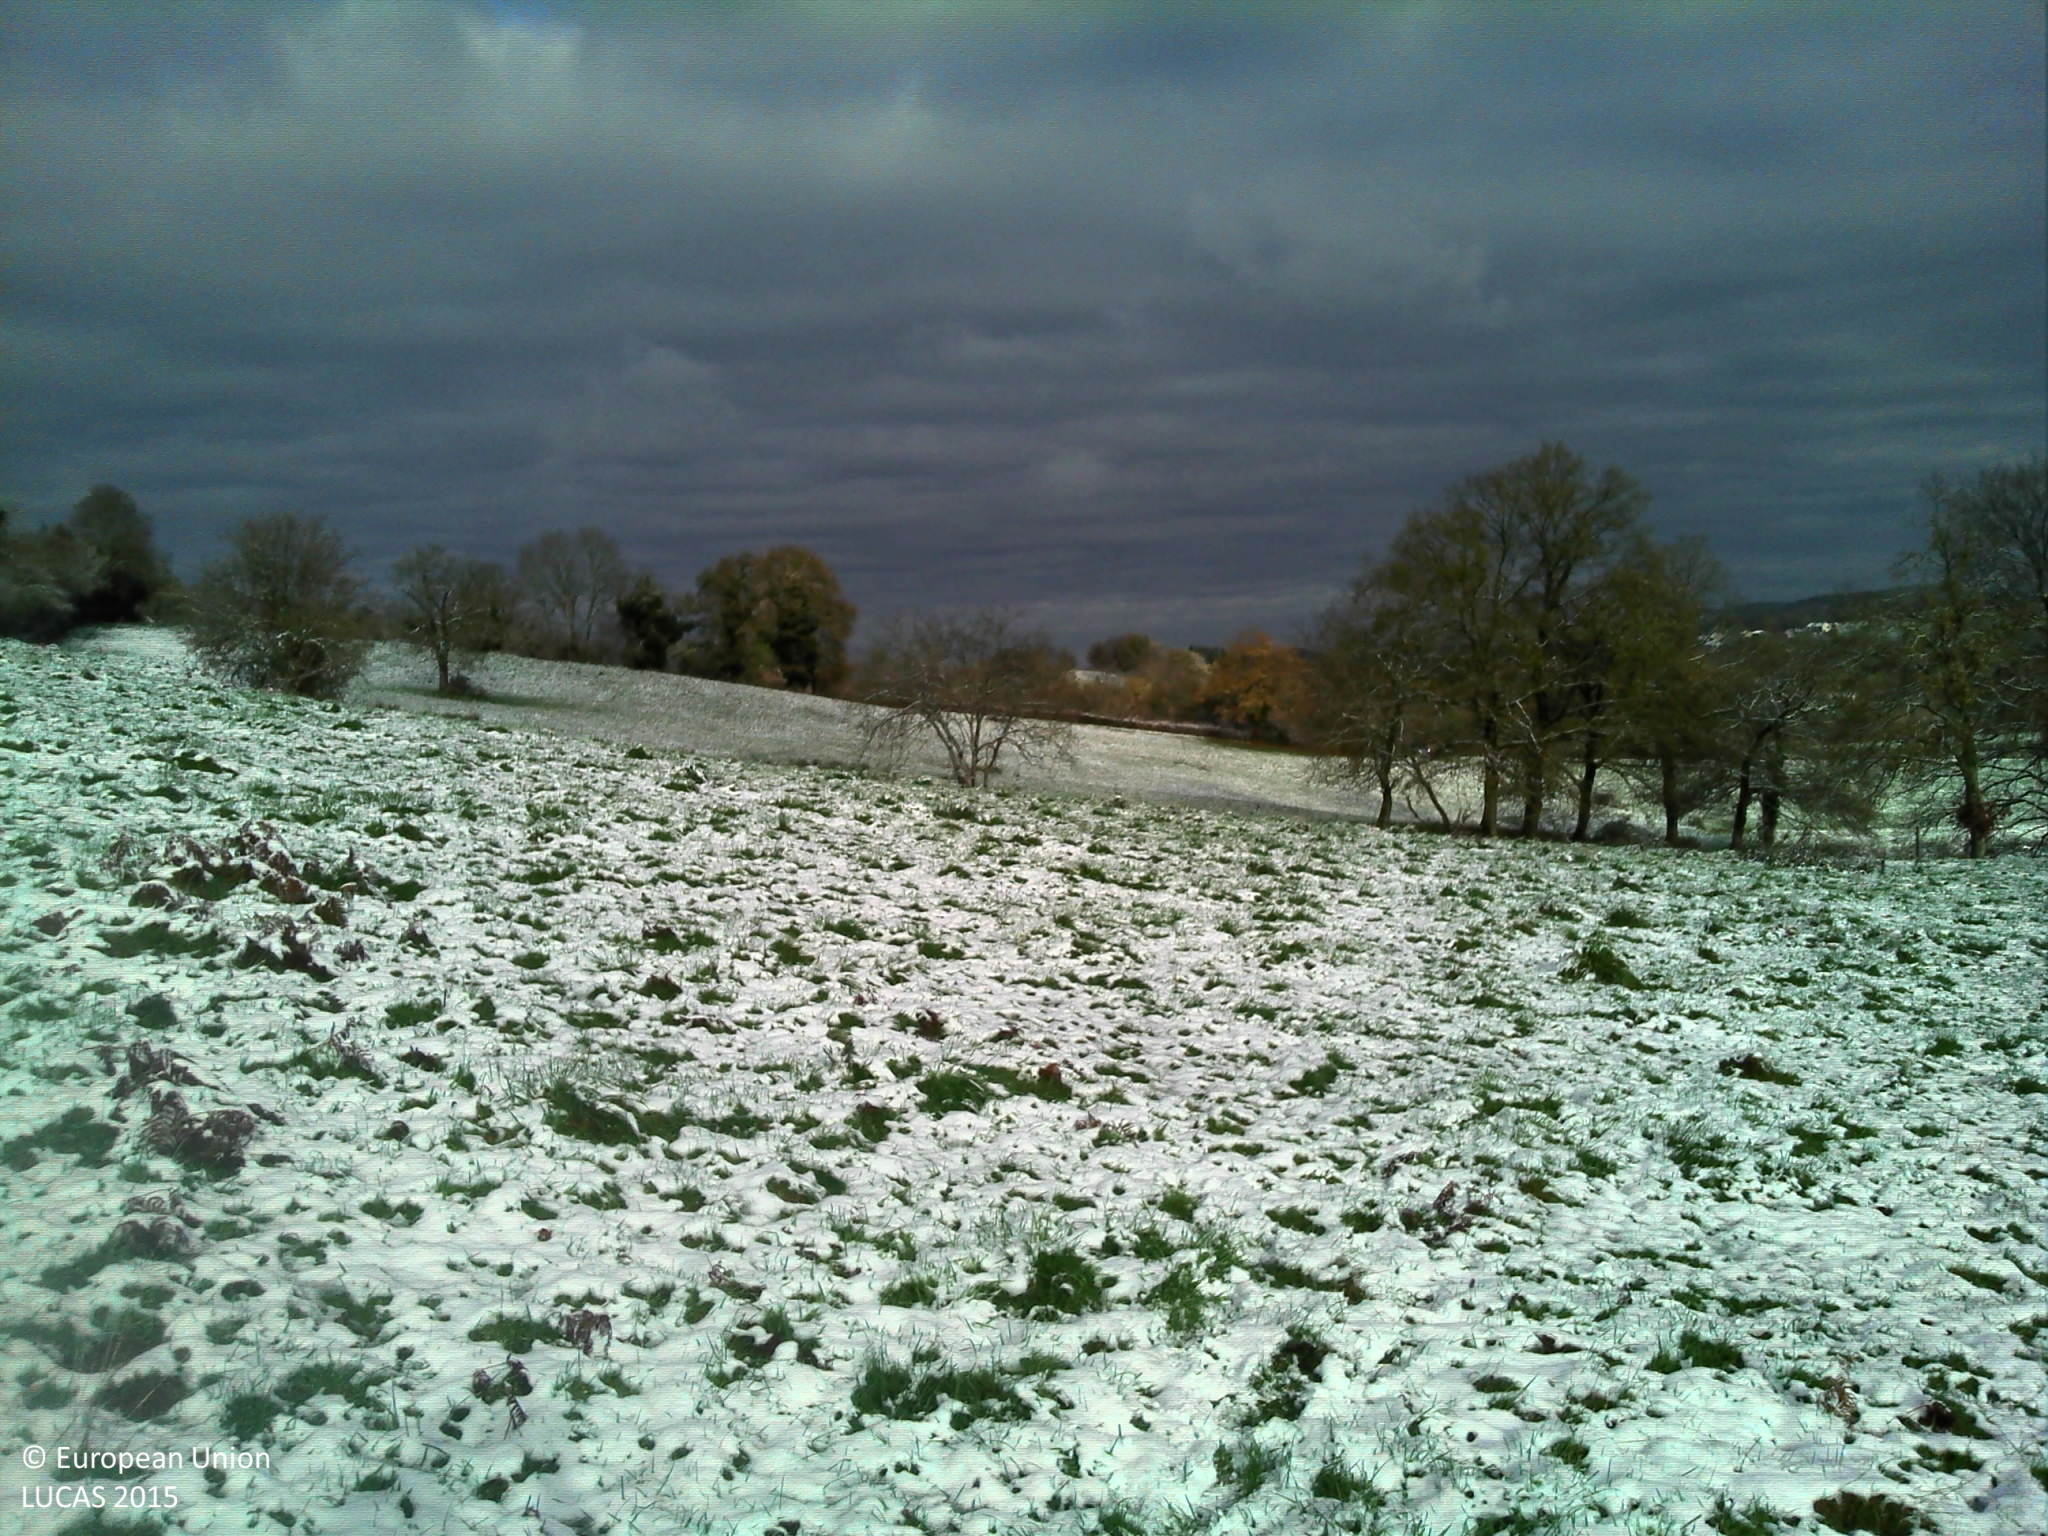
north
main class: Grassland
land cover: Grassland without tree/shrub cover
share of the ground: > 75 %
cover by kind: herbaceous plants 100 %
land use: Agriculture (excluding fallow land and kitchen gardens)
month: November
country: FR
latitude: 46.0723
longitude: 3.6522
